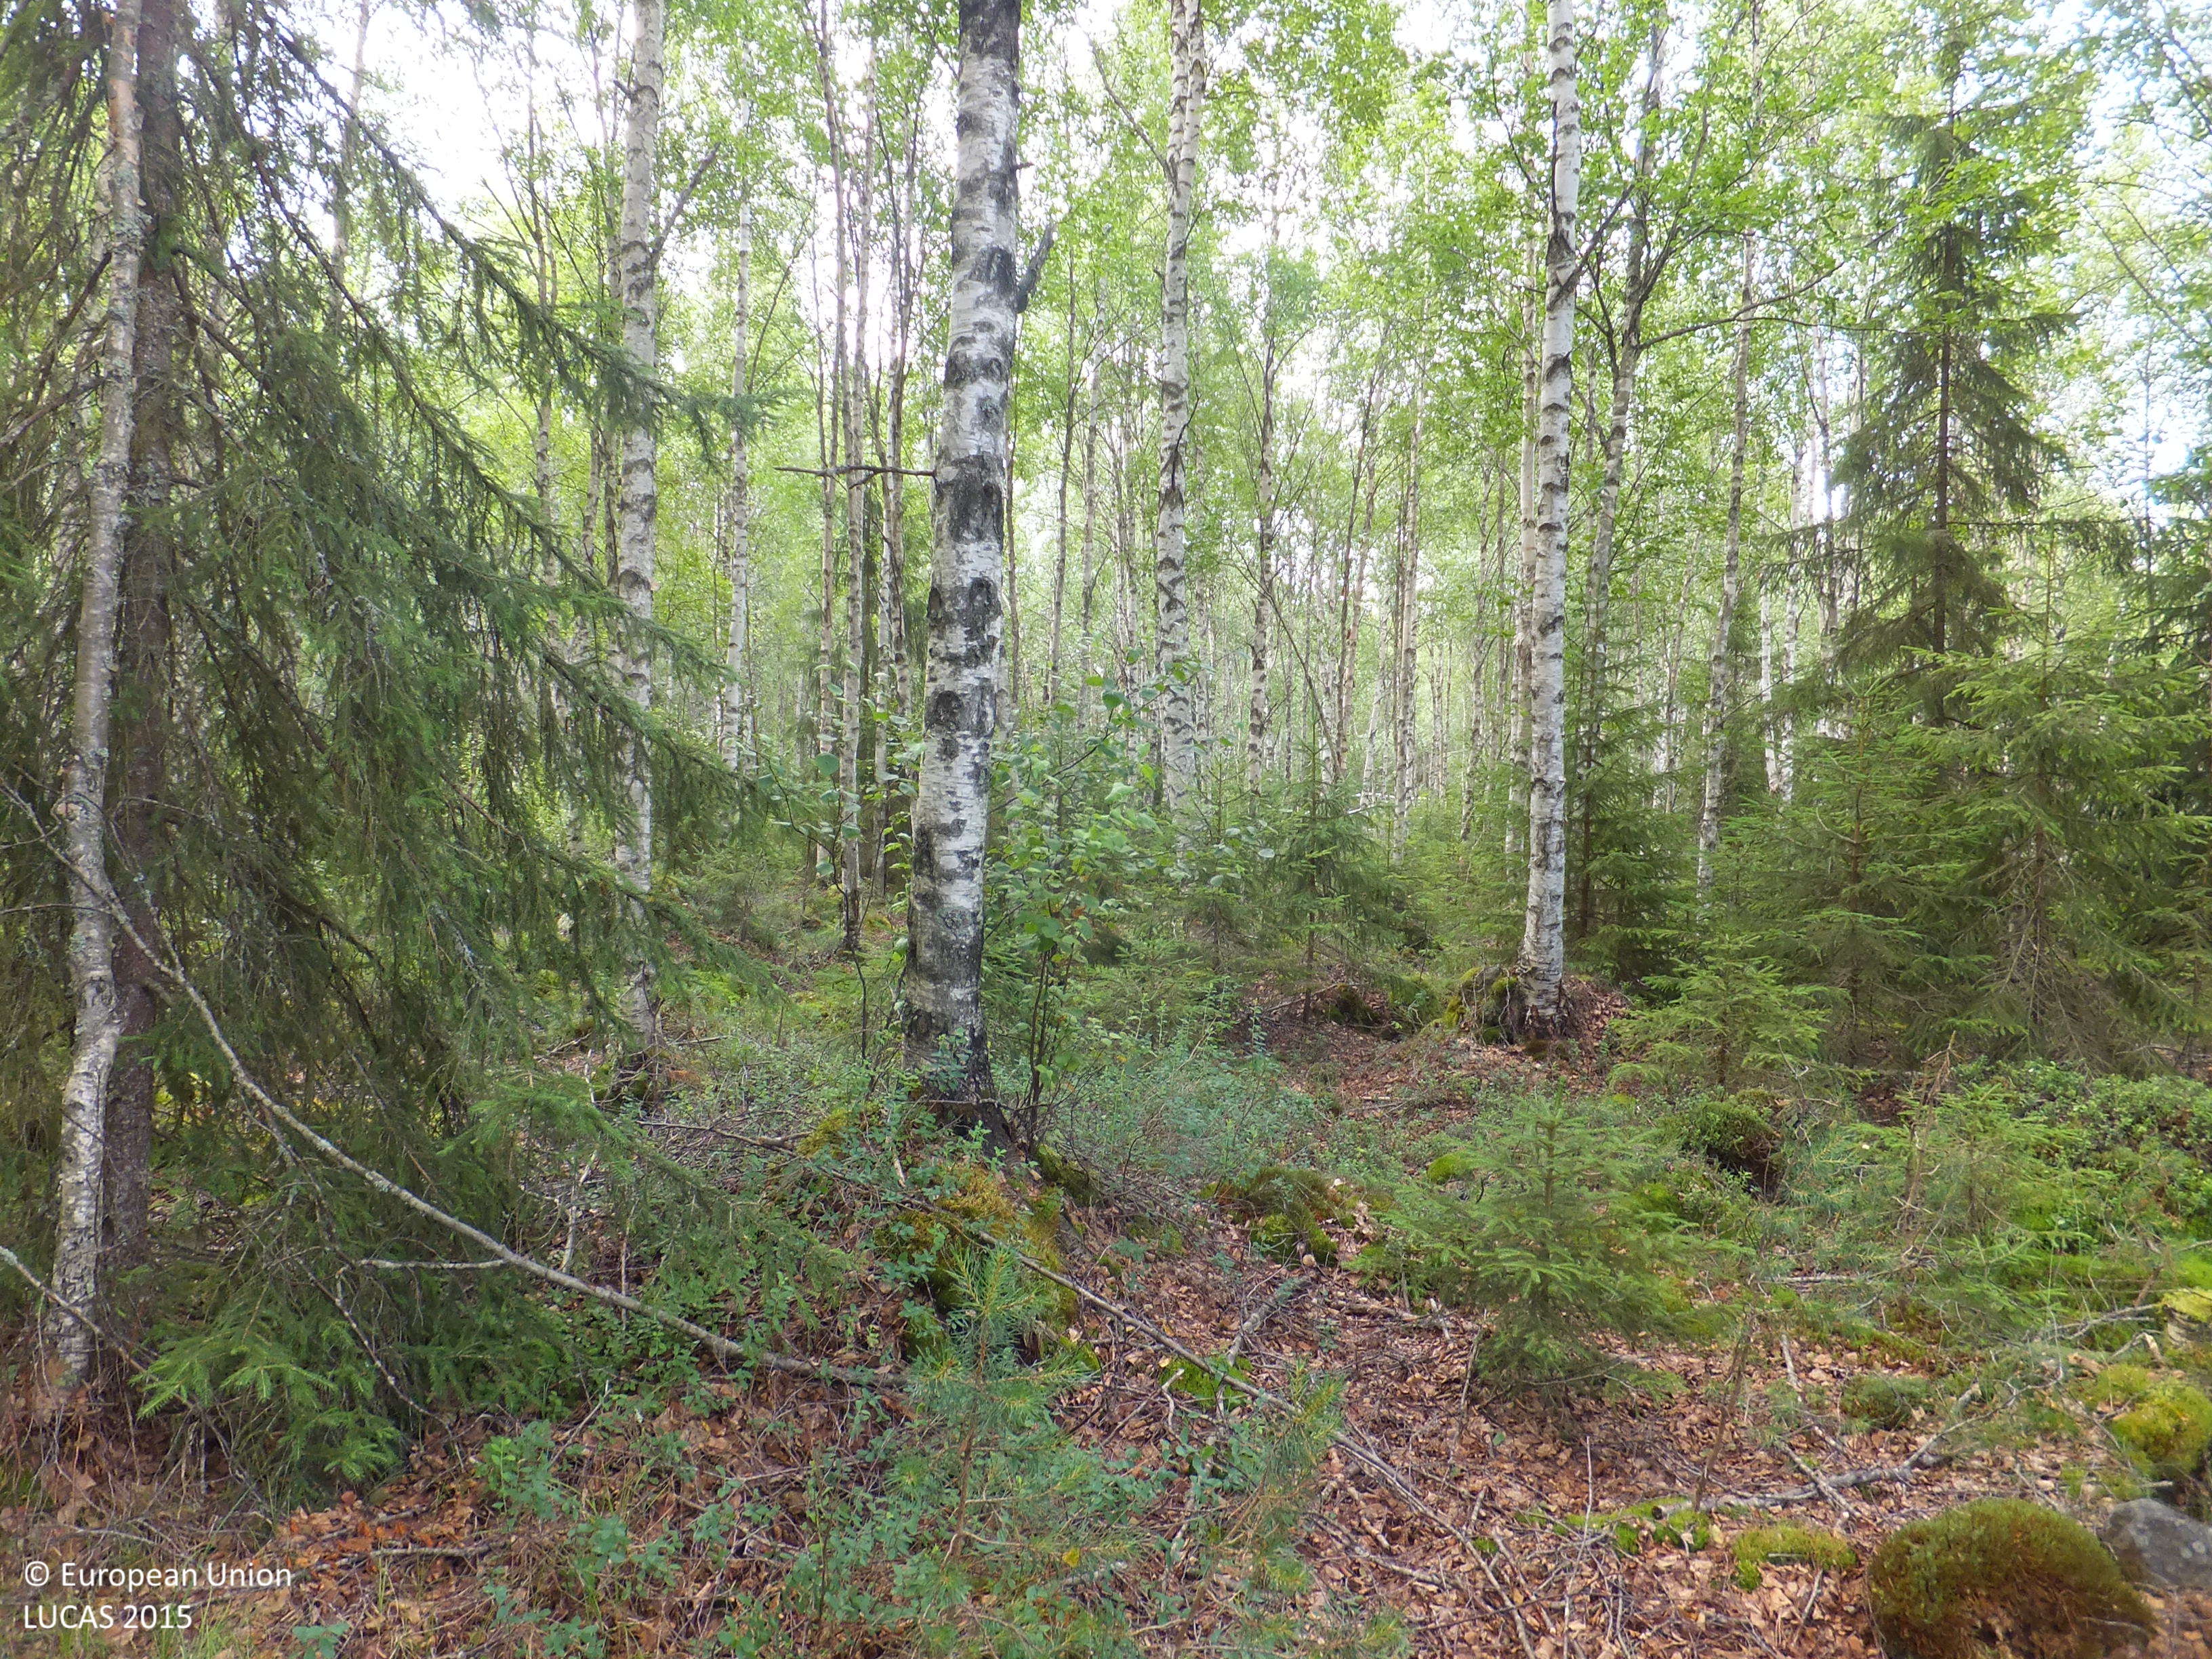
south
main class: Woodland
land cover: Spruce dominated mixed woodland
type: boreal forest
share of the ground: > 75 %
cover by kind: broadleaved forest trees 50 %, coniferous forest trees 40 %, shrubs 5 %, lichens and mosses 5 %
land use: Forestry
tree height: > 5 m
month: July
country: FI
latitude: 63.6211
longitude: 23.2296
